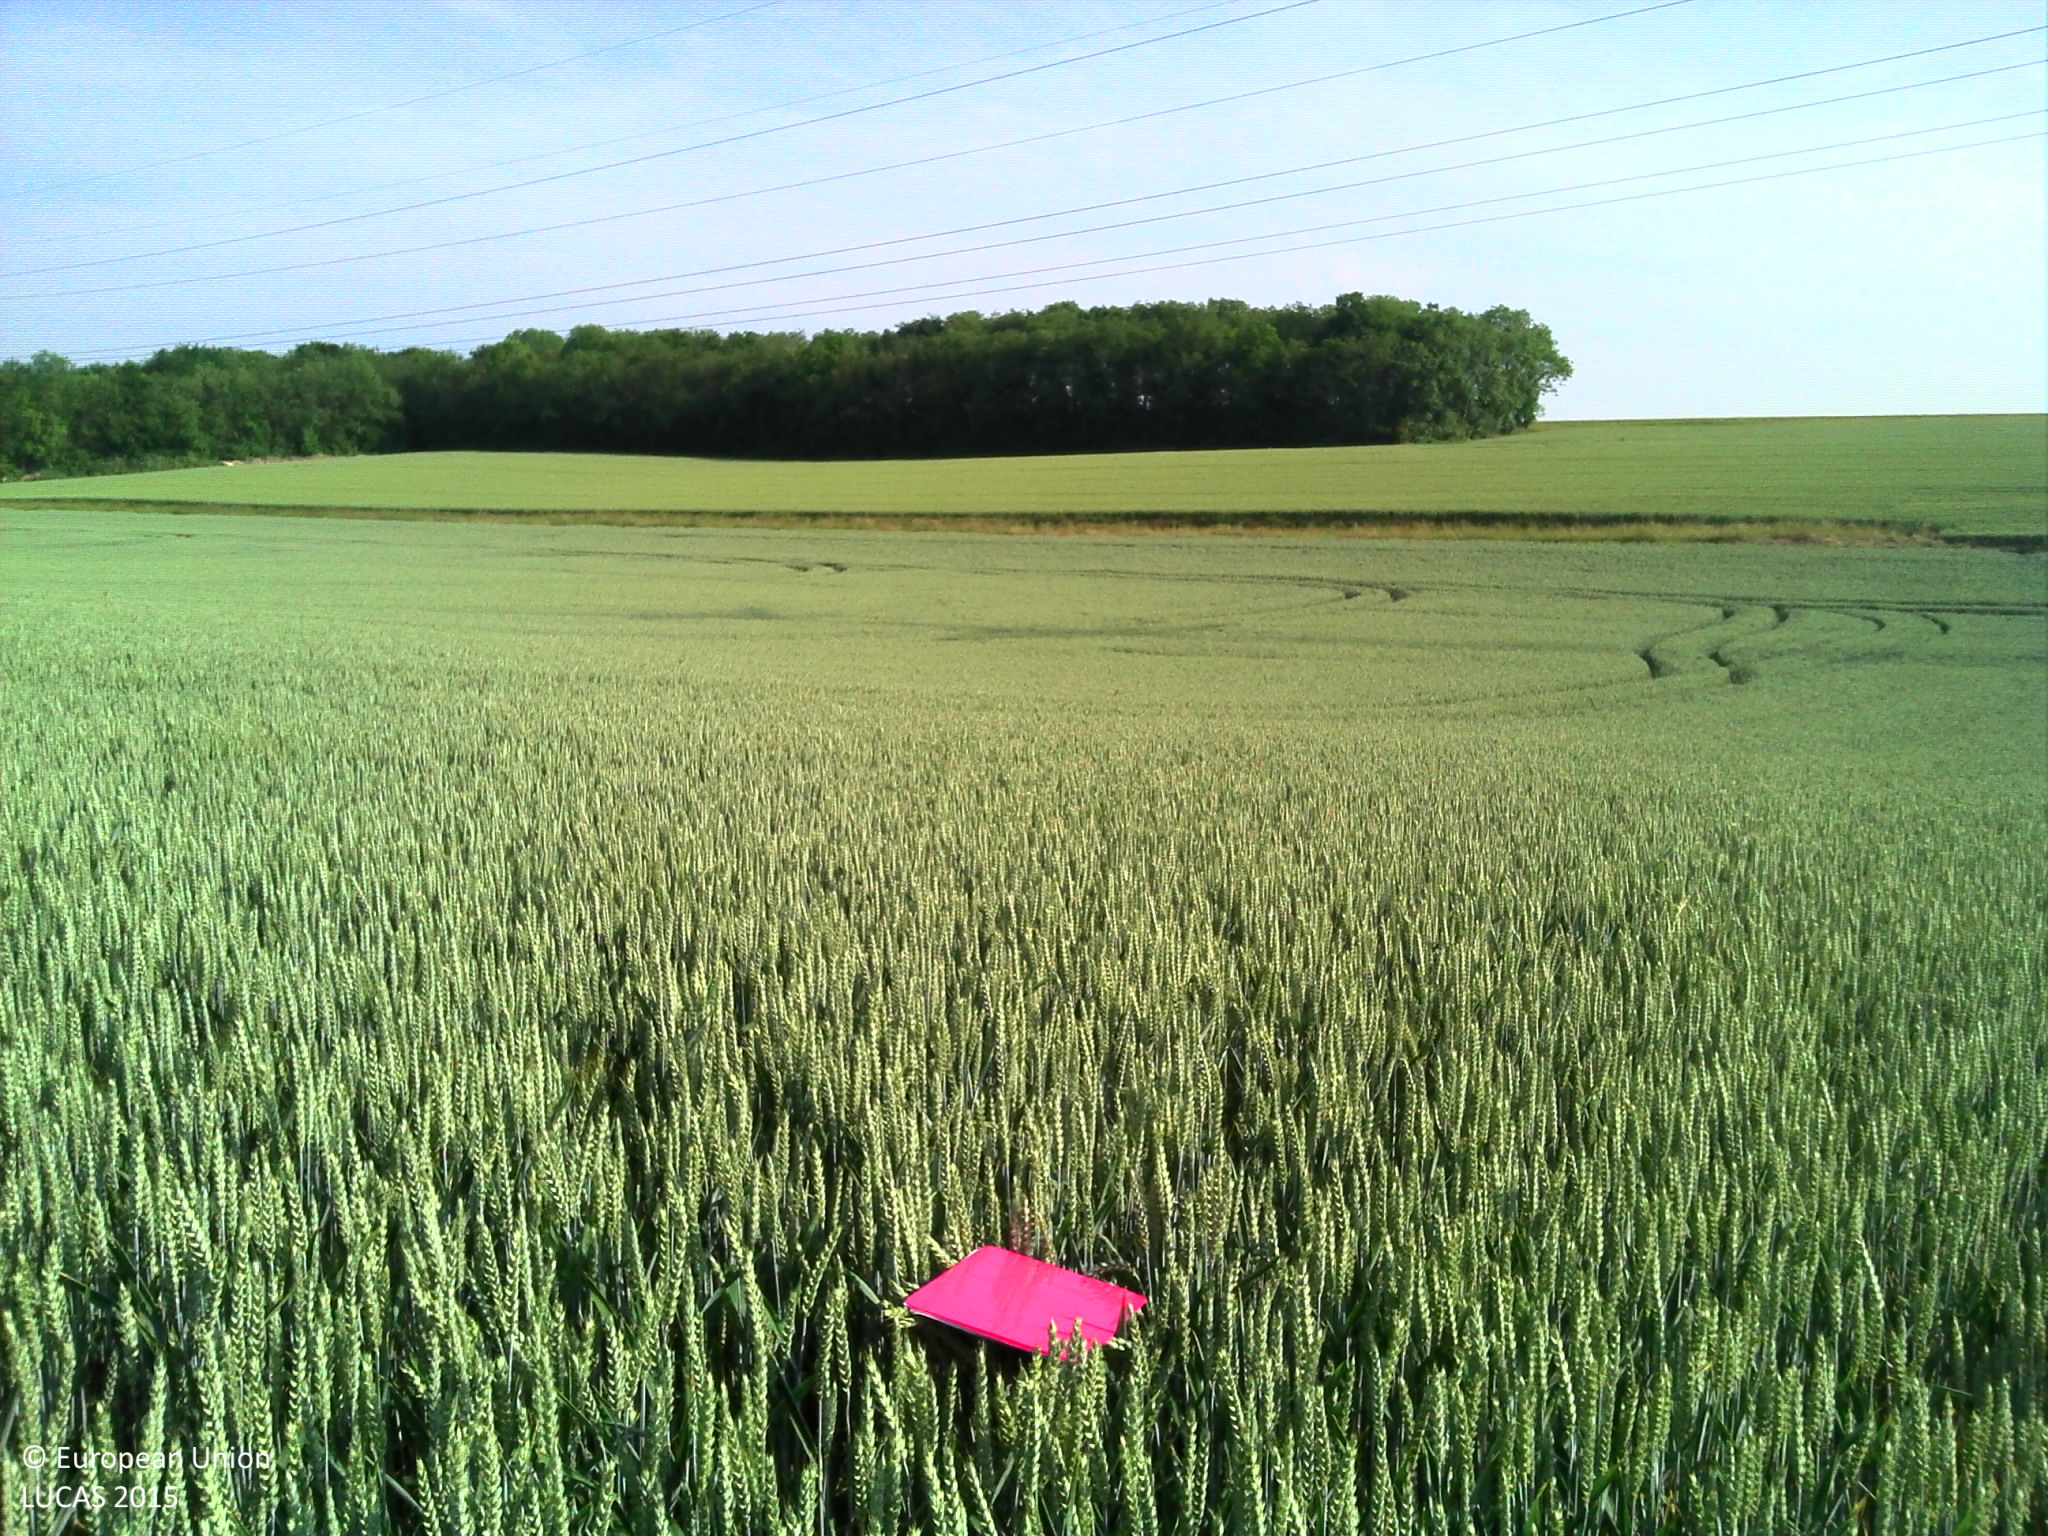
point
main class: Cropland
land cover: Common wheat
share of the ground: > 75 %
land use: Agriculture (excluding fallow land and kitchen gardens)
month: June
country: FR
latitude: 49.4690
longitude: 2.5228
